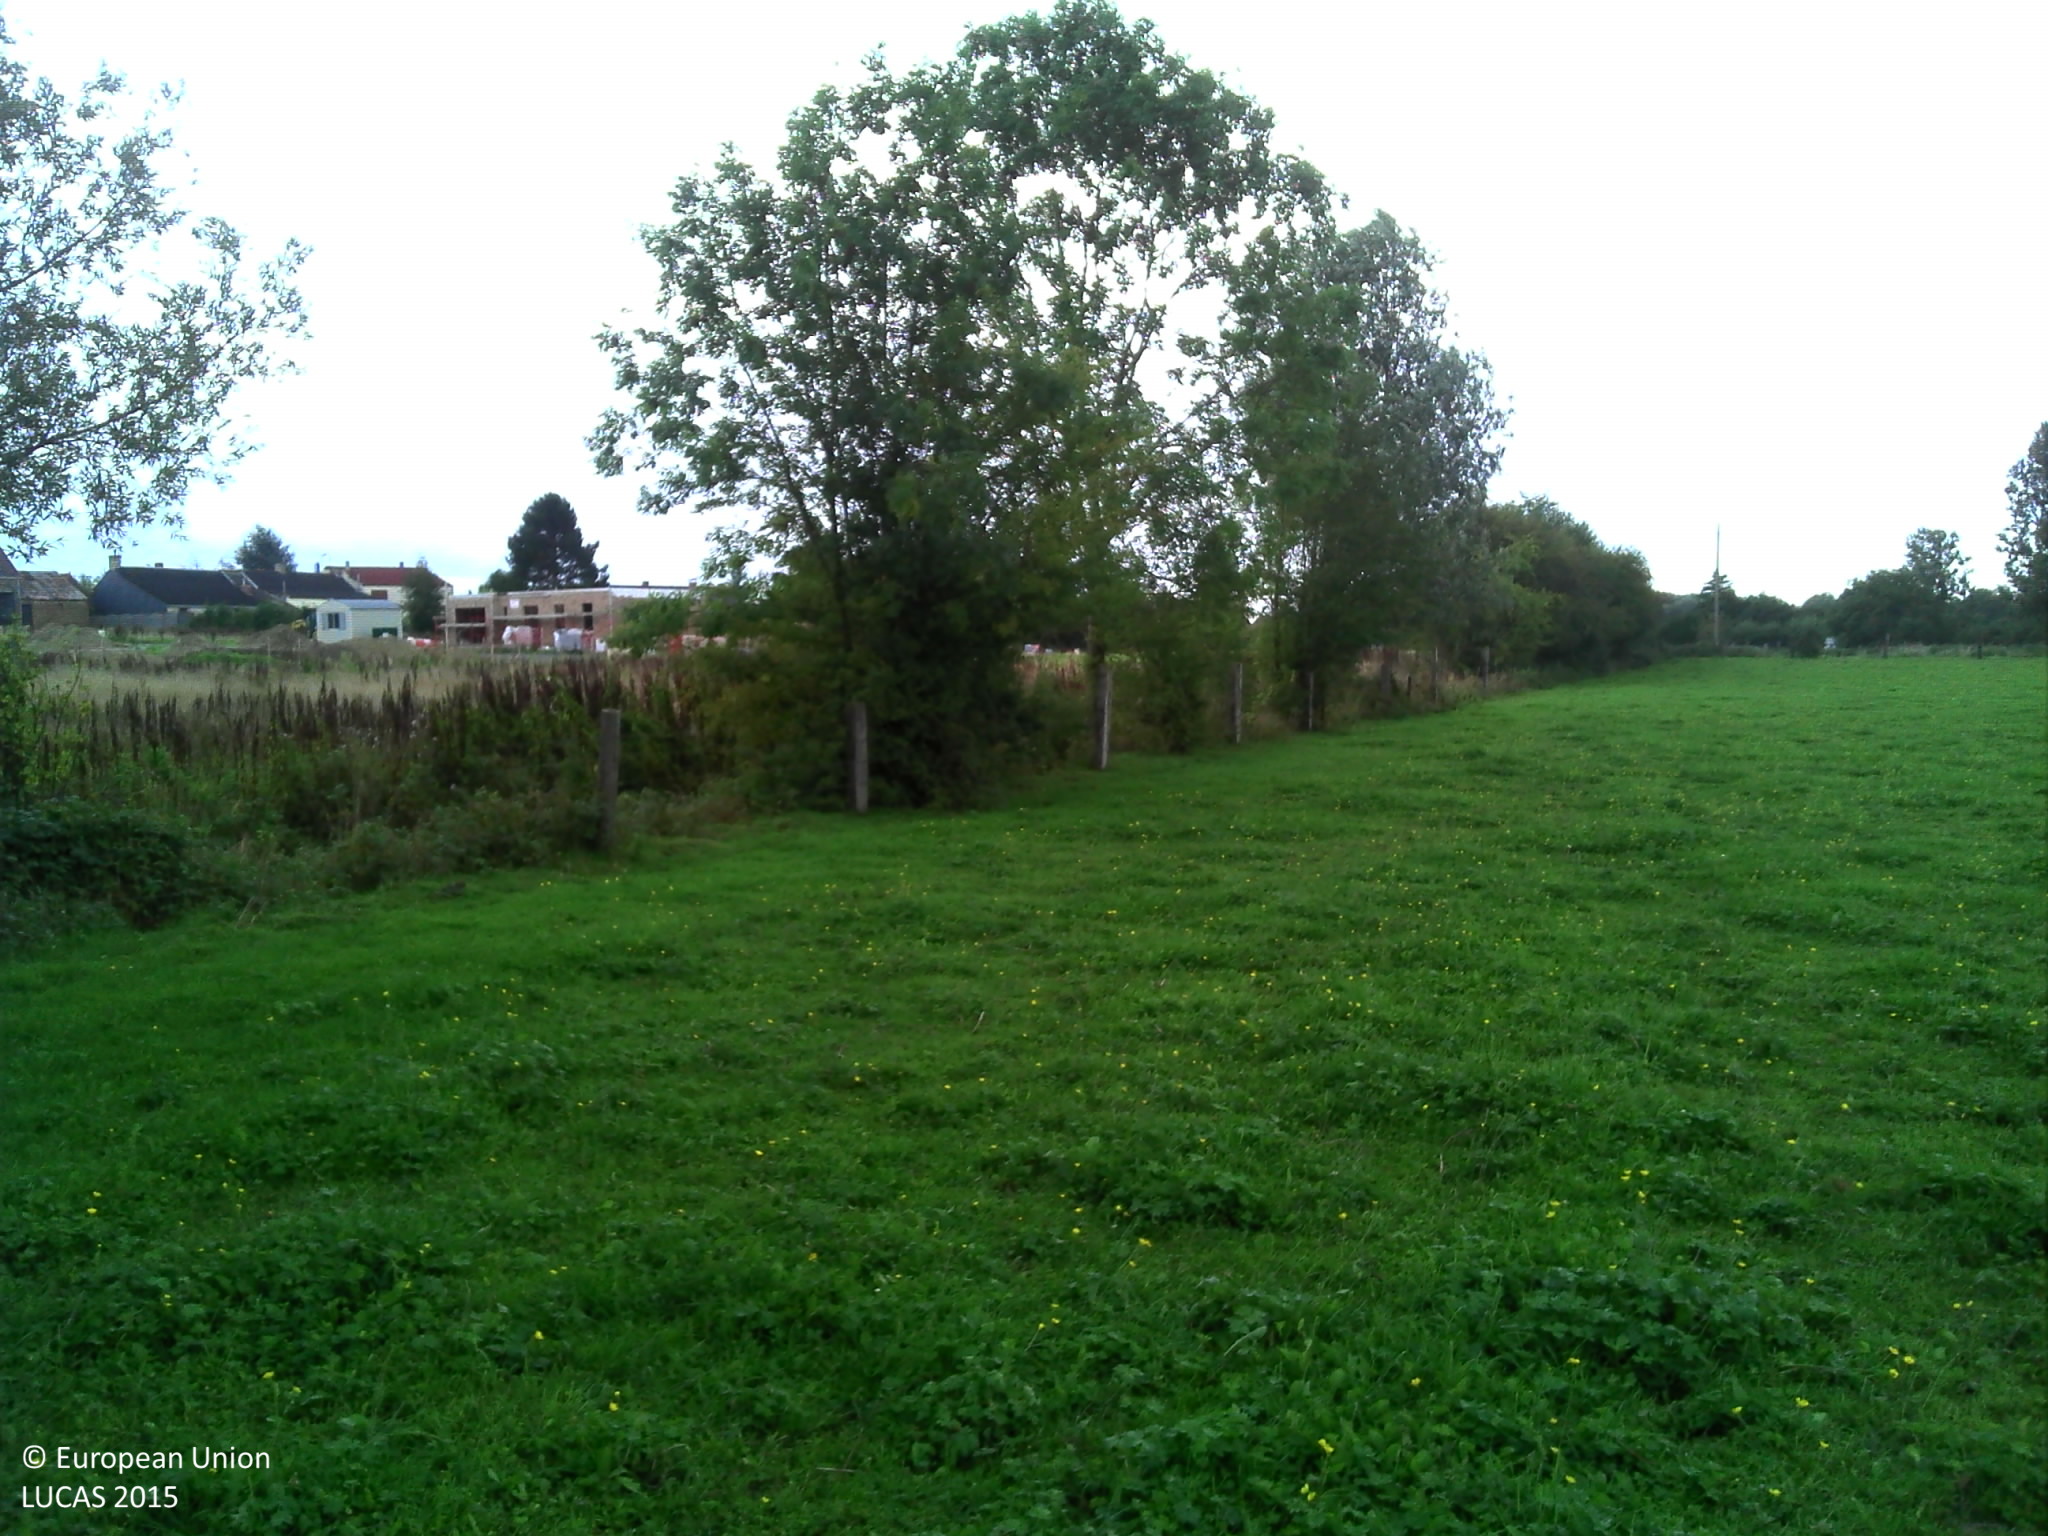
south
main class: Grassland
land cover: Grassland without tree/shrub cover
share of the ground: > 75 %
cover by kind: herbaceous plants 95 %, consolidated bare surface 5 %
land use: Agriculture (excluding fallow land and kitchen gardens)
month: September
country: FR
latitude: 50.4903
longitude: 3.5792
